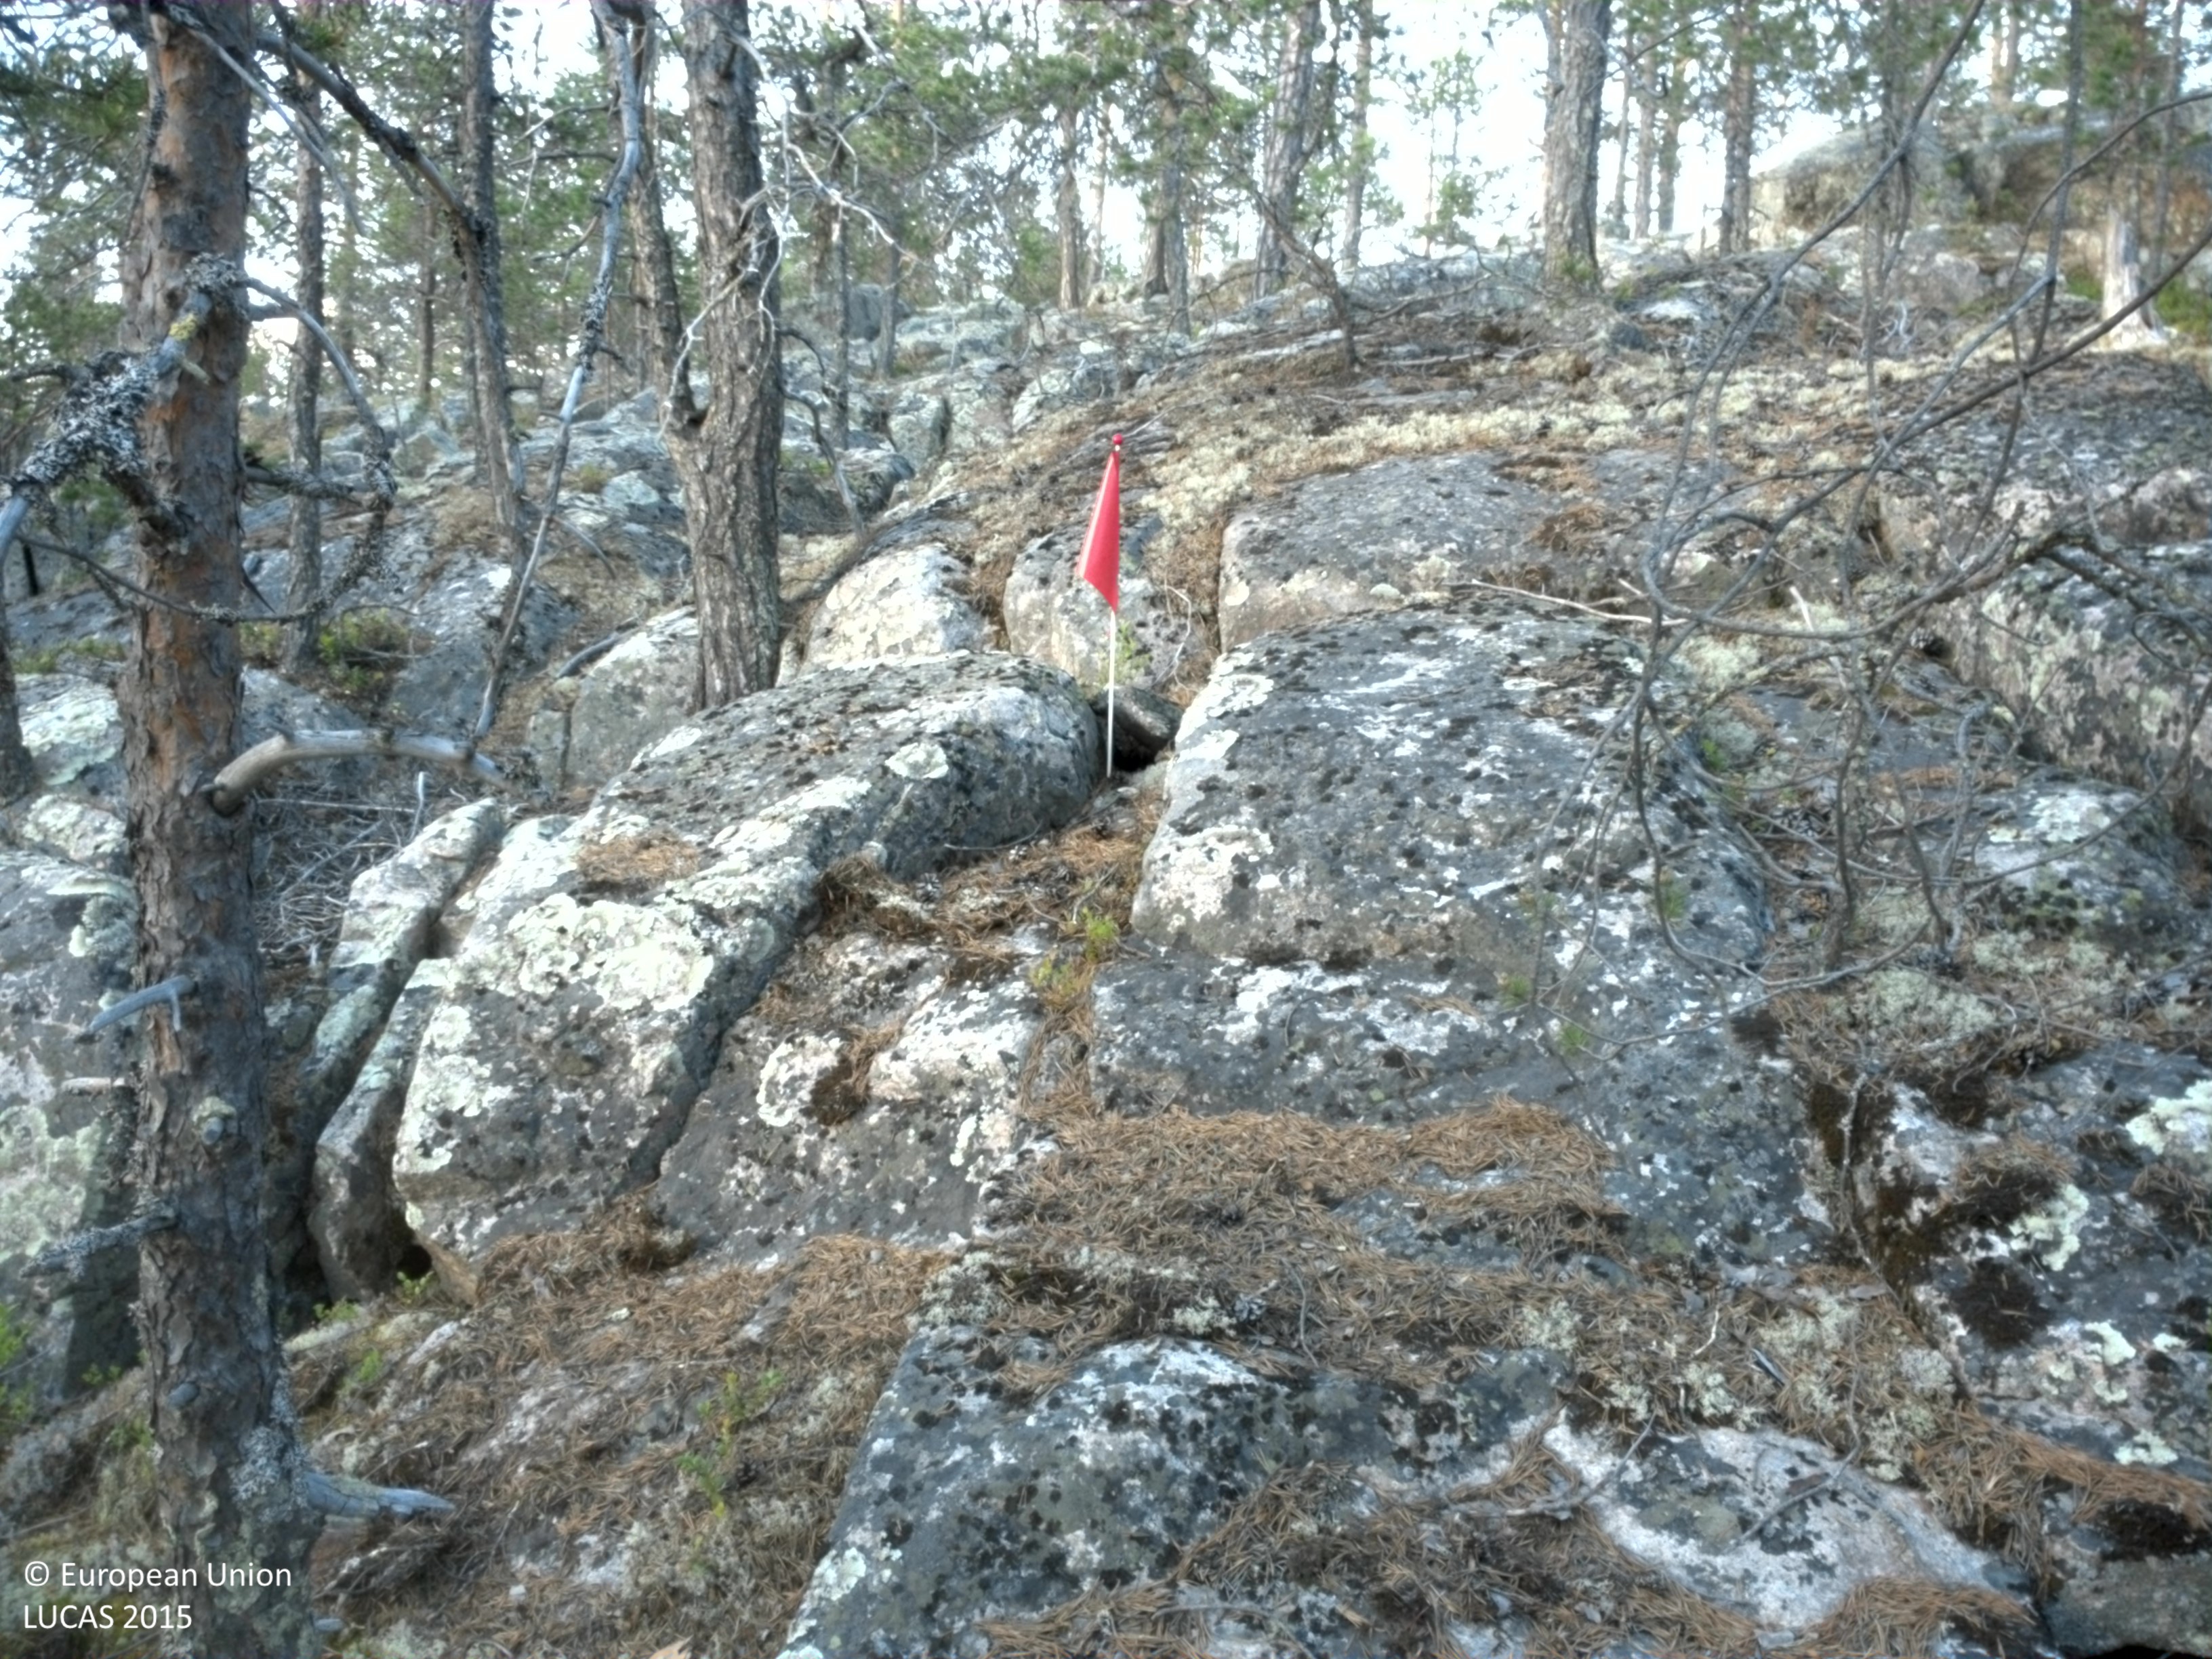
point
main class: Woodland
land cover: Pine dominated coniferous woodland
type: boreal forest
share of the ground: 10 - 25 %
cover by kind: consolidated bare surface 60 %, coniferous forest trees 20 %, lichens and mosses 15 %, shrubs 5 %
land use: Semi-natural and natural areas not in use
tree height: > 5 m
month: June
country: SE
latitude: 66.3163
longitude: 22.8509
